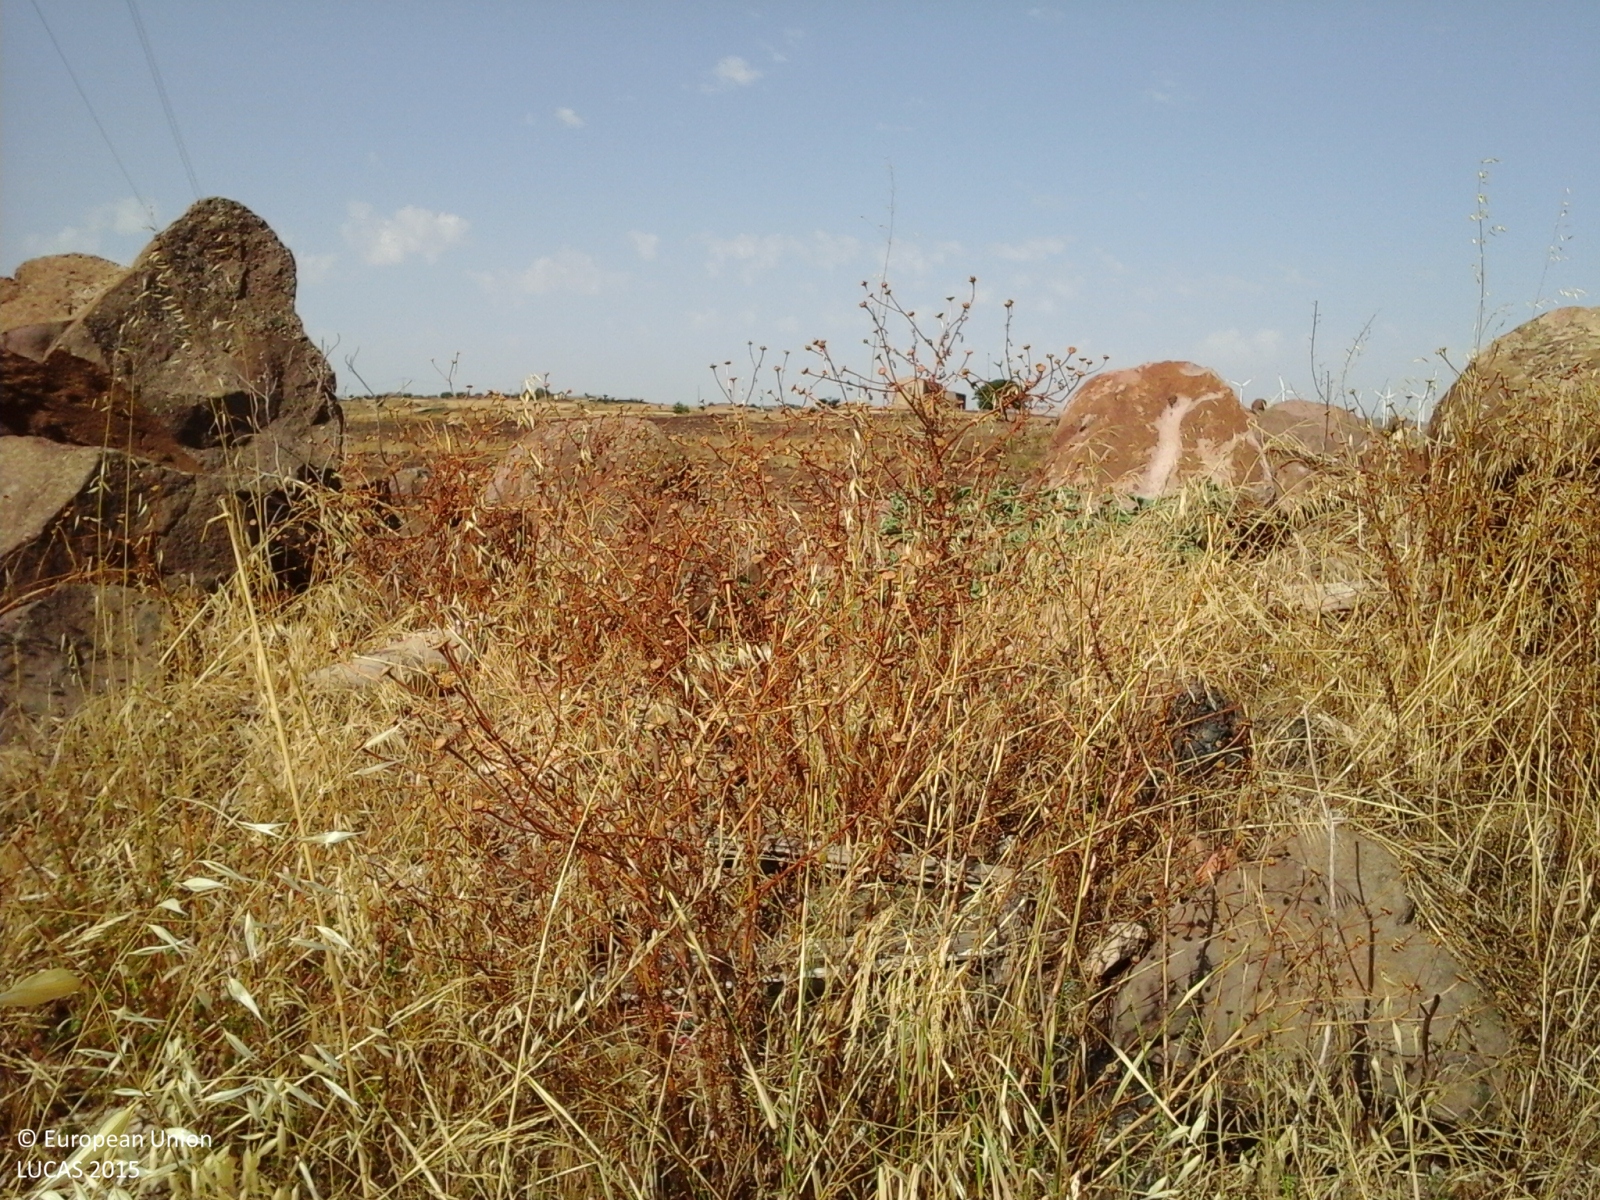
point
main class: Grassland
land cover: Grassland without tree/shrub cover
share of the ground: > 75 %
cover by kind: herbaceous plants 95 %, consolidated bare surface 5 %
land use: Agriculture (excluding fallow land and kitchen gardens)
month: August
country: IT
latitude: 37.2410
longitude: 14.8669
